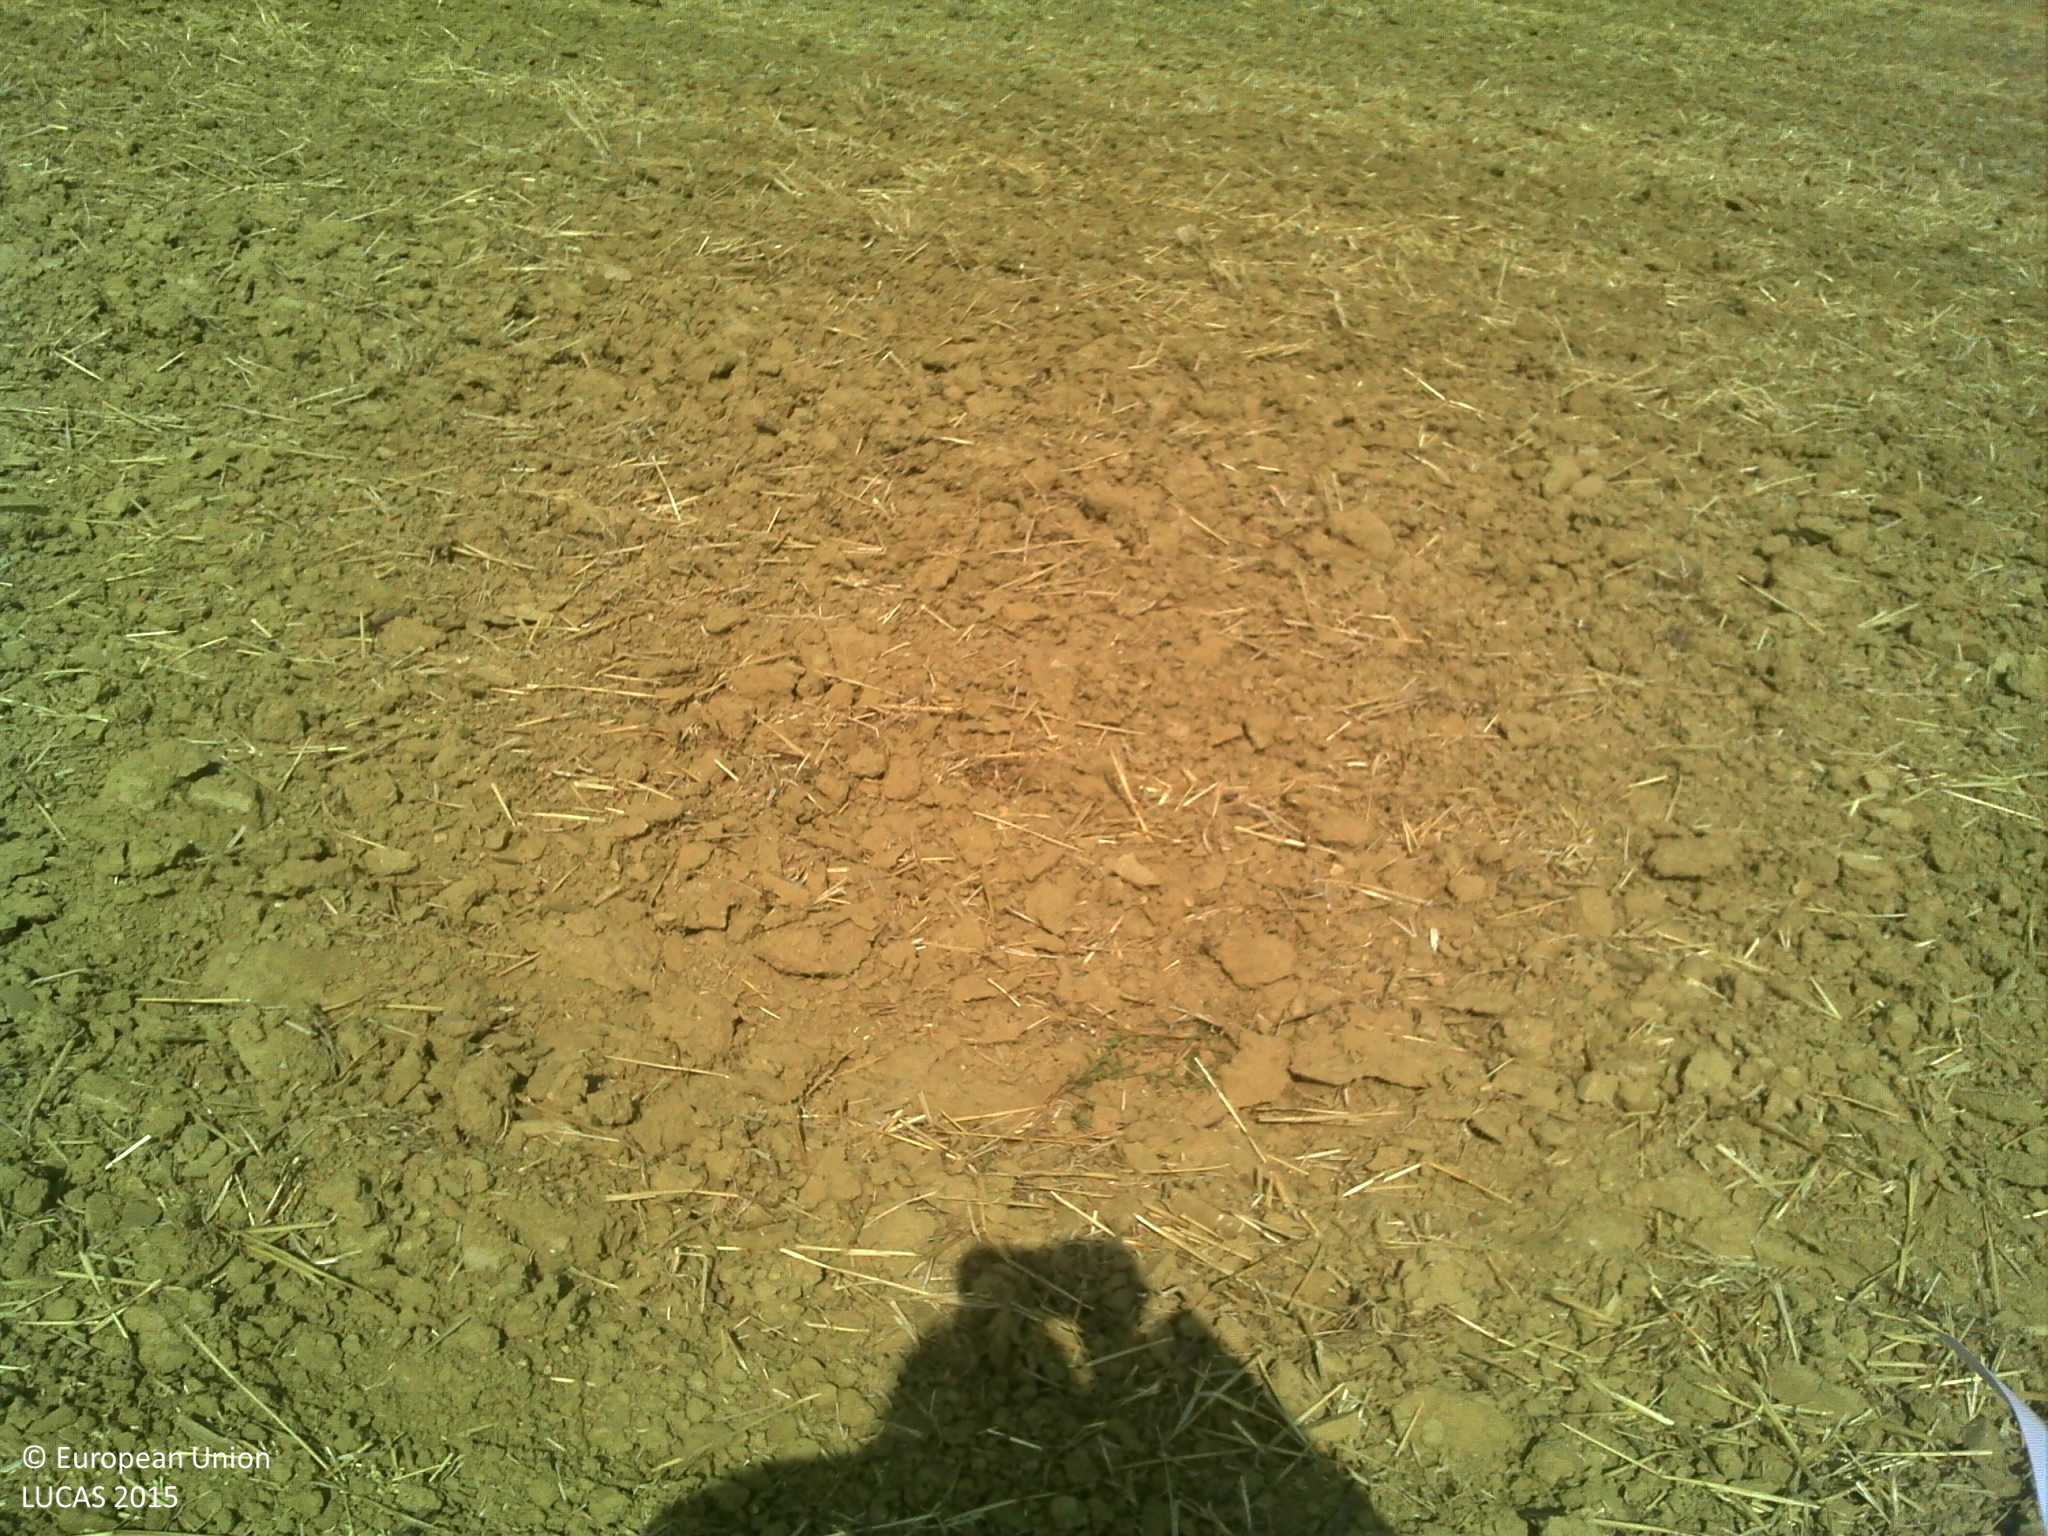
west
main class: Cropland
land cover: Common wheat
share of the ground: < 10 %
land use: Agriculture (excluding fallow land and kitchen gardens)
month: July
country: FR
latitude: 43.8504
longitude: 1.0051
